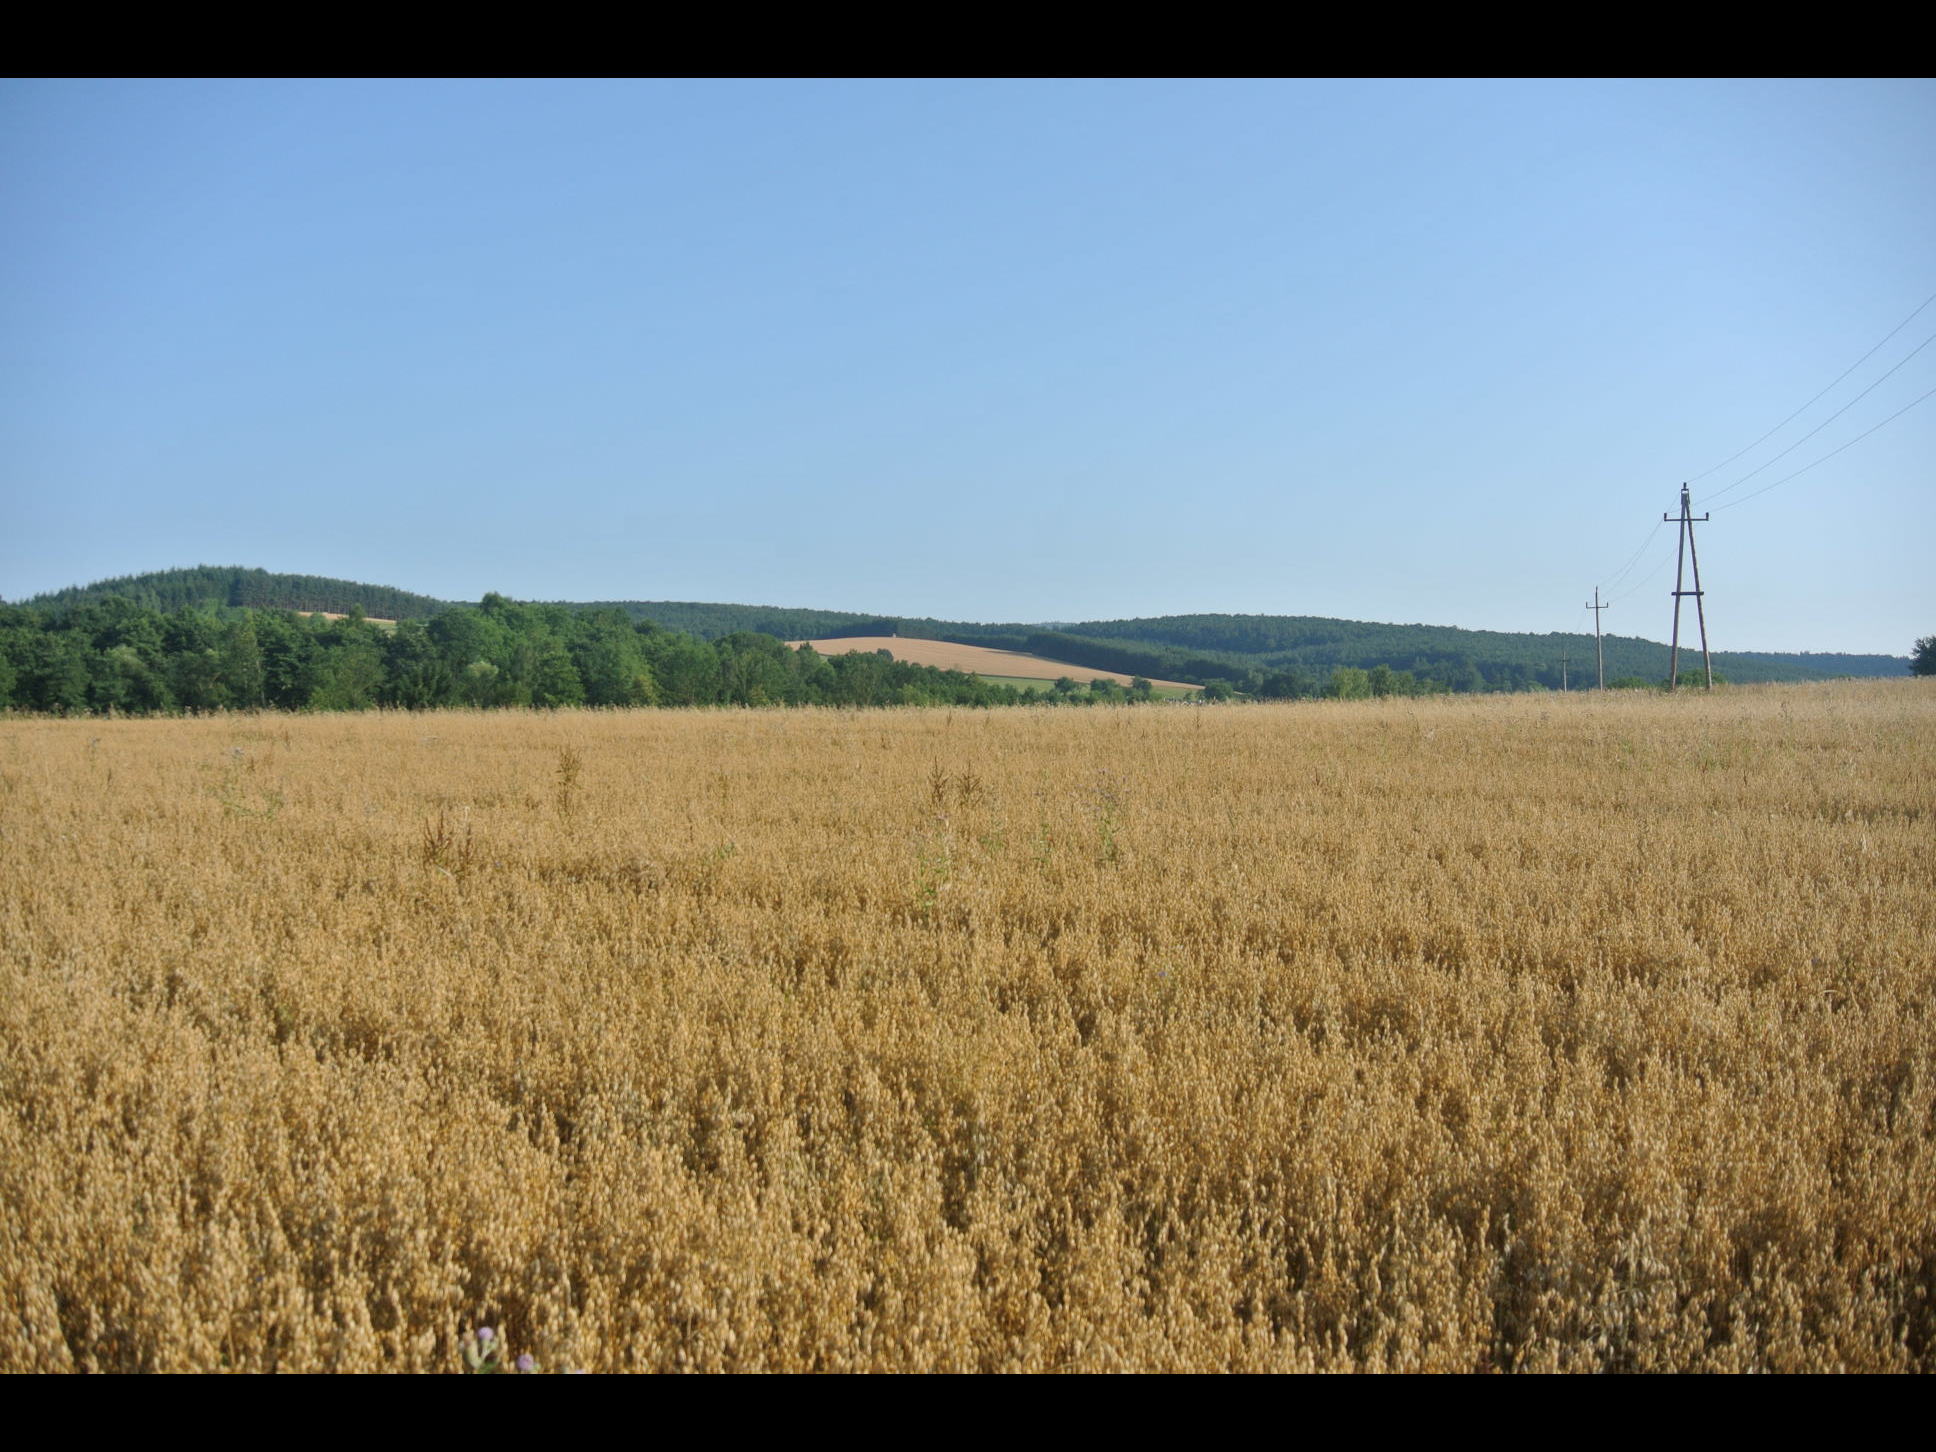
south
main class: Cropland
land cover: Oats
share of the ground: > 75 %
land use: Agriculture (excluding fallow land and kitchen gardens)
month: July
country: AT
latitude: 47.4070
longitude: 16.3773
